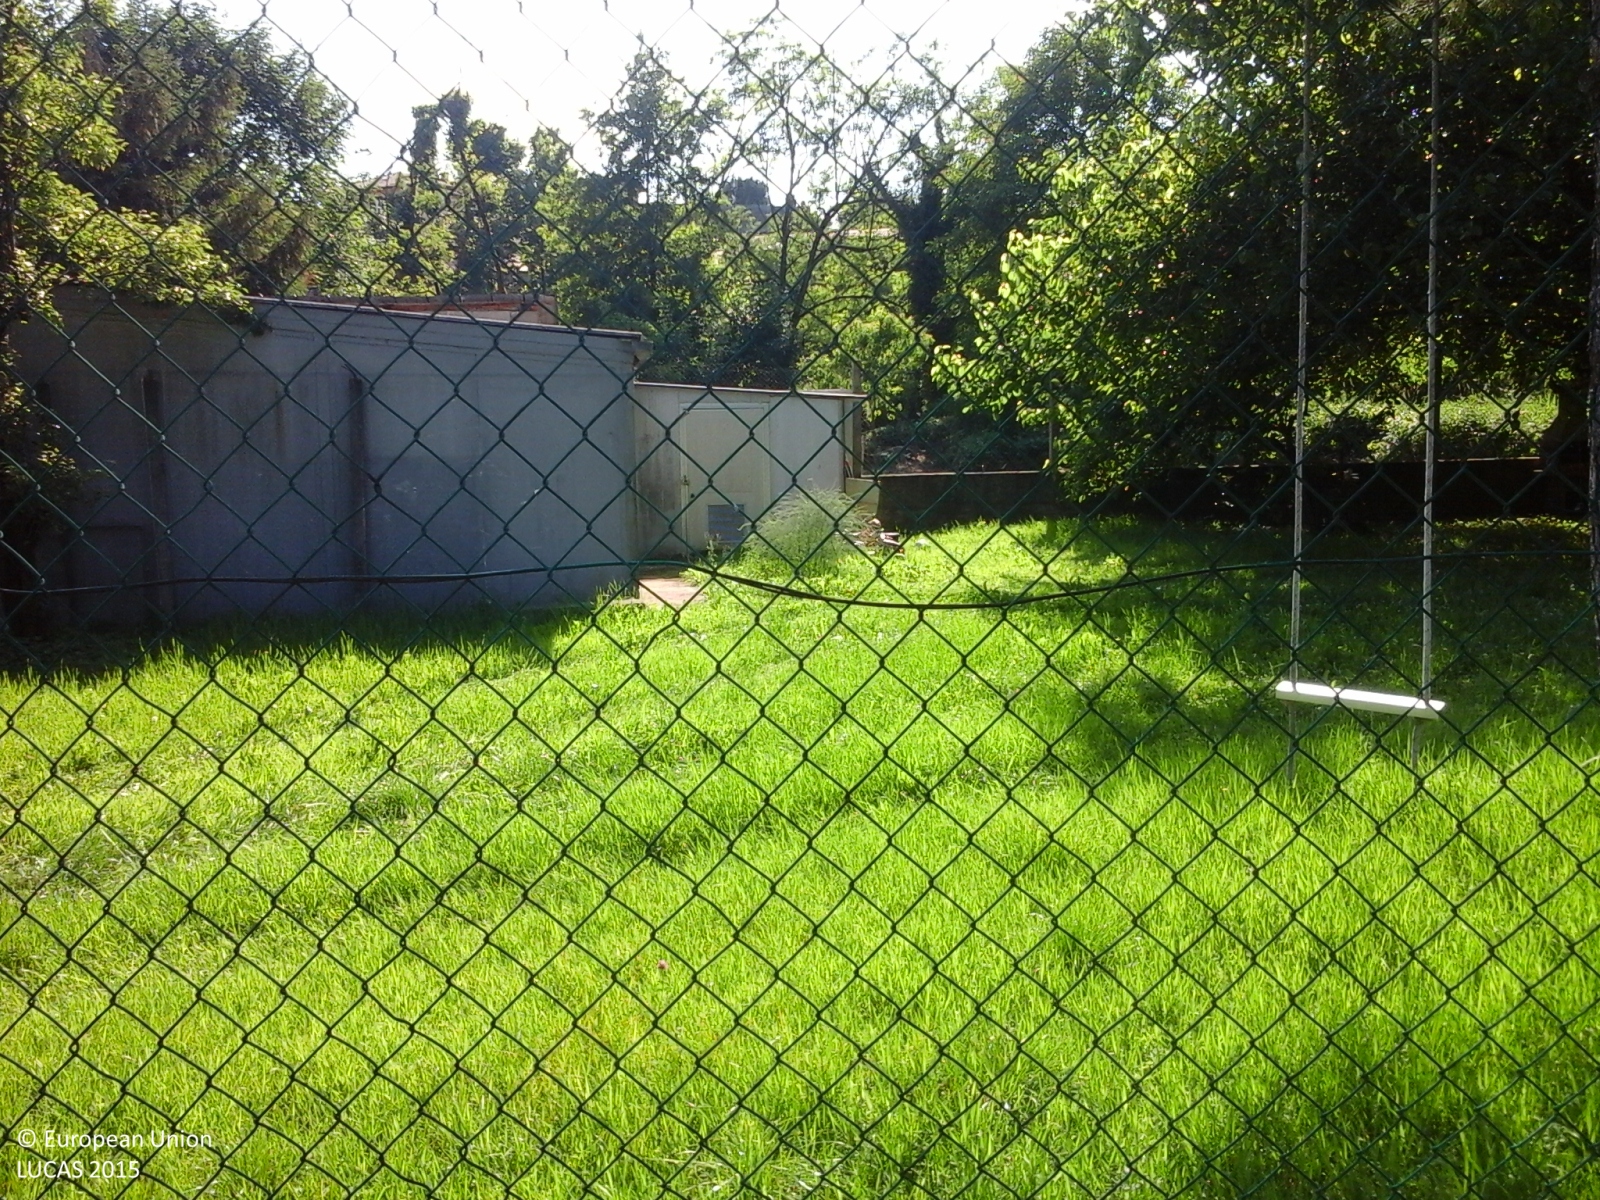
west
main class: Woodland
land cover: Broadleaved woodland
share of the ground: 50 - 75 %
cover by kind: broadleaved forest trees 75 %, herbaceous plants 15 %, coniferous forest trees 10 %
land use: Residential
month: June
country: IT
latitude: 45.6819
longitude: 9.2437
